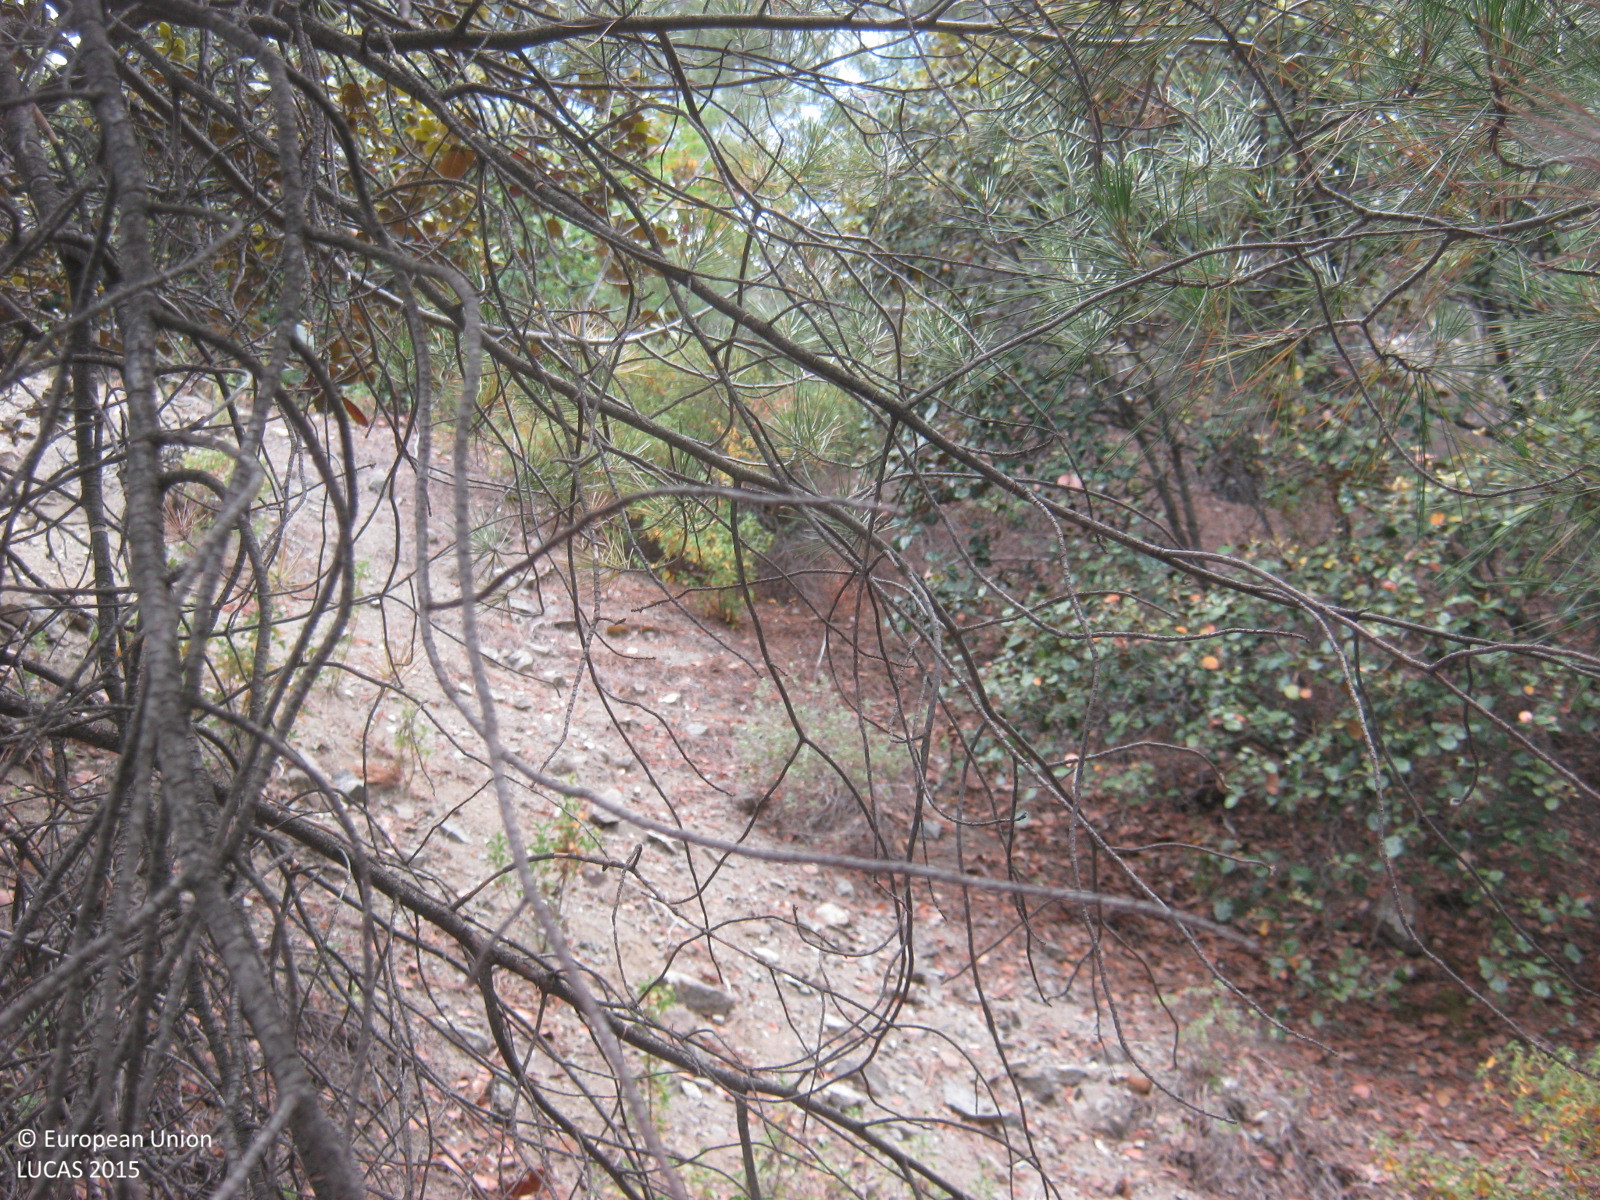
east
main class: Woodland
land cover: Pine dominated mixed woodland
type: coniferous forest of the mediterranean region
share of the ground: > 75 %
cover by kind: coniferous forest trees 45 %, broadleaved forest trees 30 %, unconsolidated bare surface 15 %, shrubs 10 %
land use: Forestry
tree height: > 5 m
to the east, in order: Pine dominated mixed woodland; Tracks; Pine dominated mixed woodland; Tracks; Pine dominated mixed woodland
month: June
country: CY
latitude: 34.9812
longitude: 32.8538
